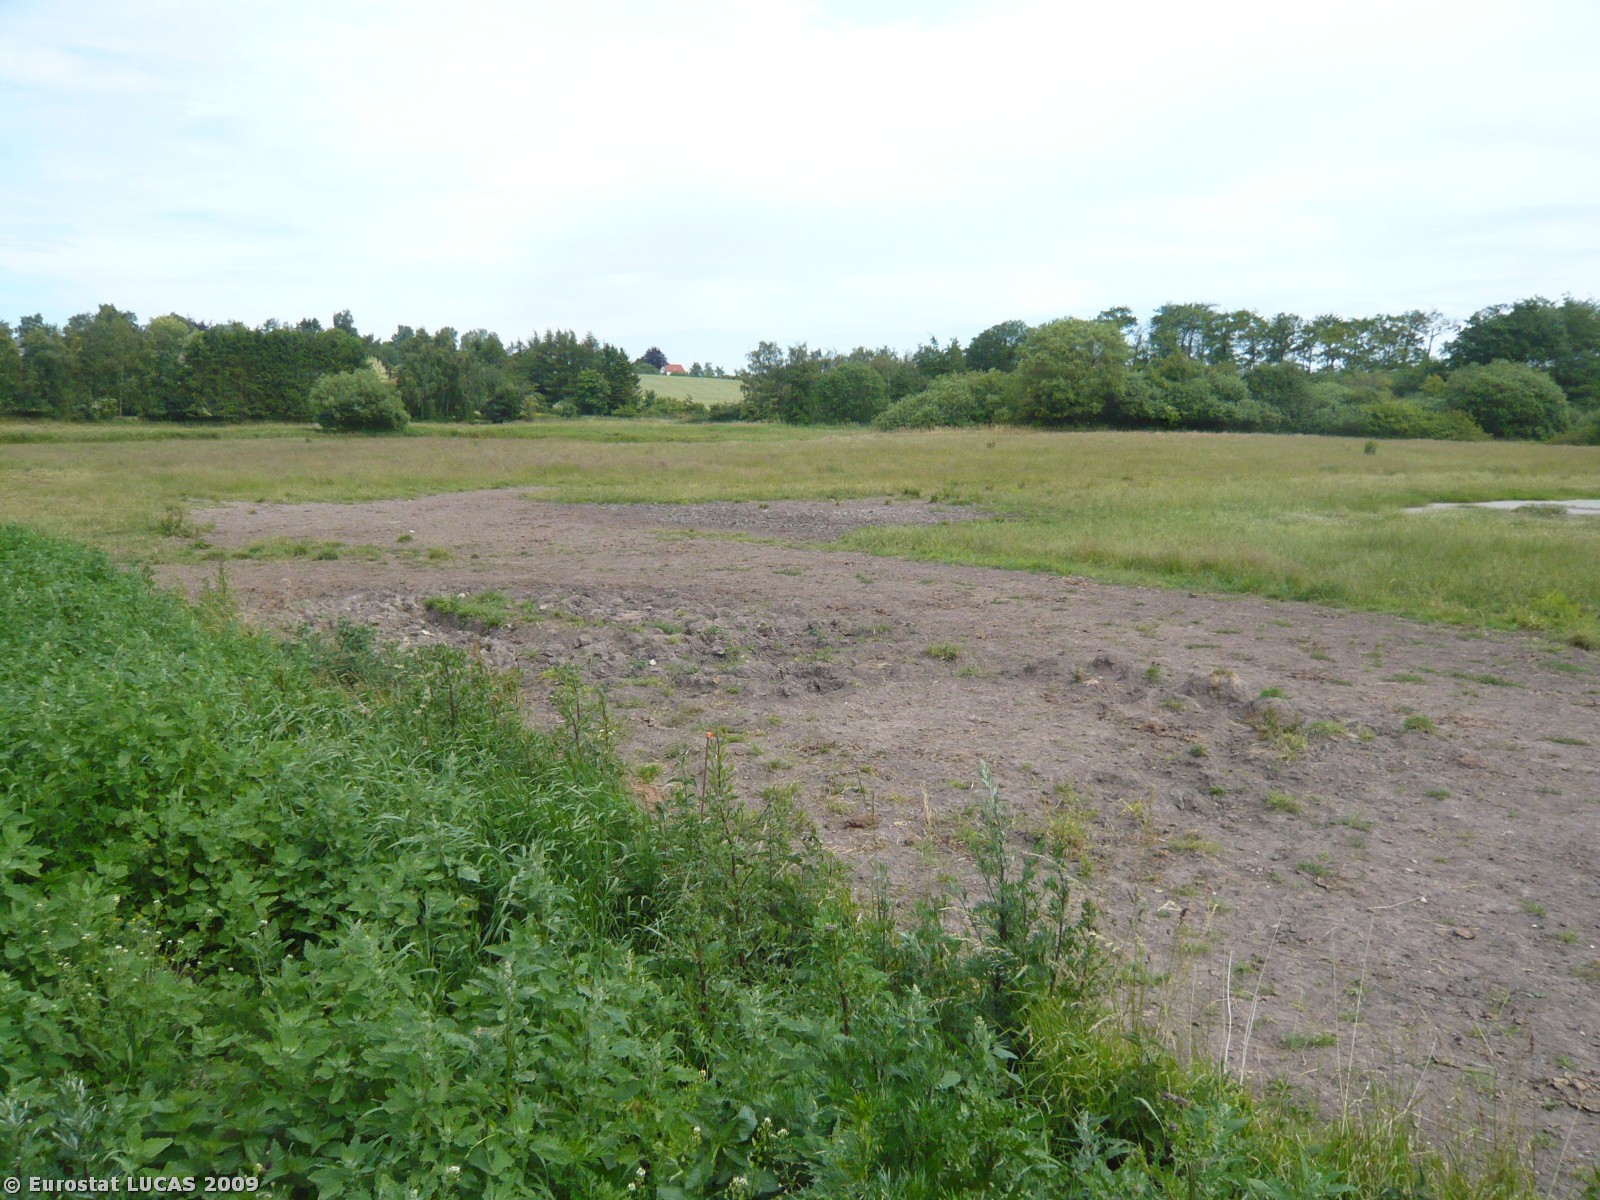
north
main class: Grassland
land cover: Grassland without tree/shrub cover
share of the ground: > 75 %
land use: Agriculture (excluding fallow land and kitchen gardens)
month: June
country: DK
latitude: 55.2156
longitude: 10.6125
